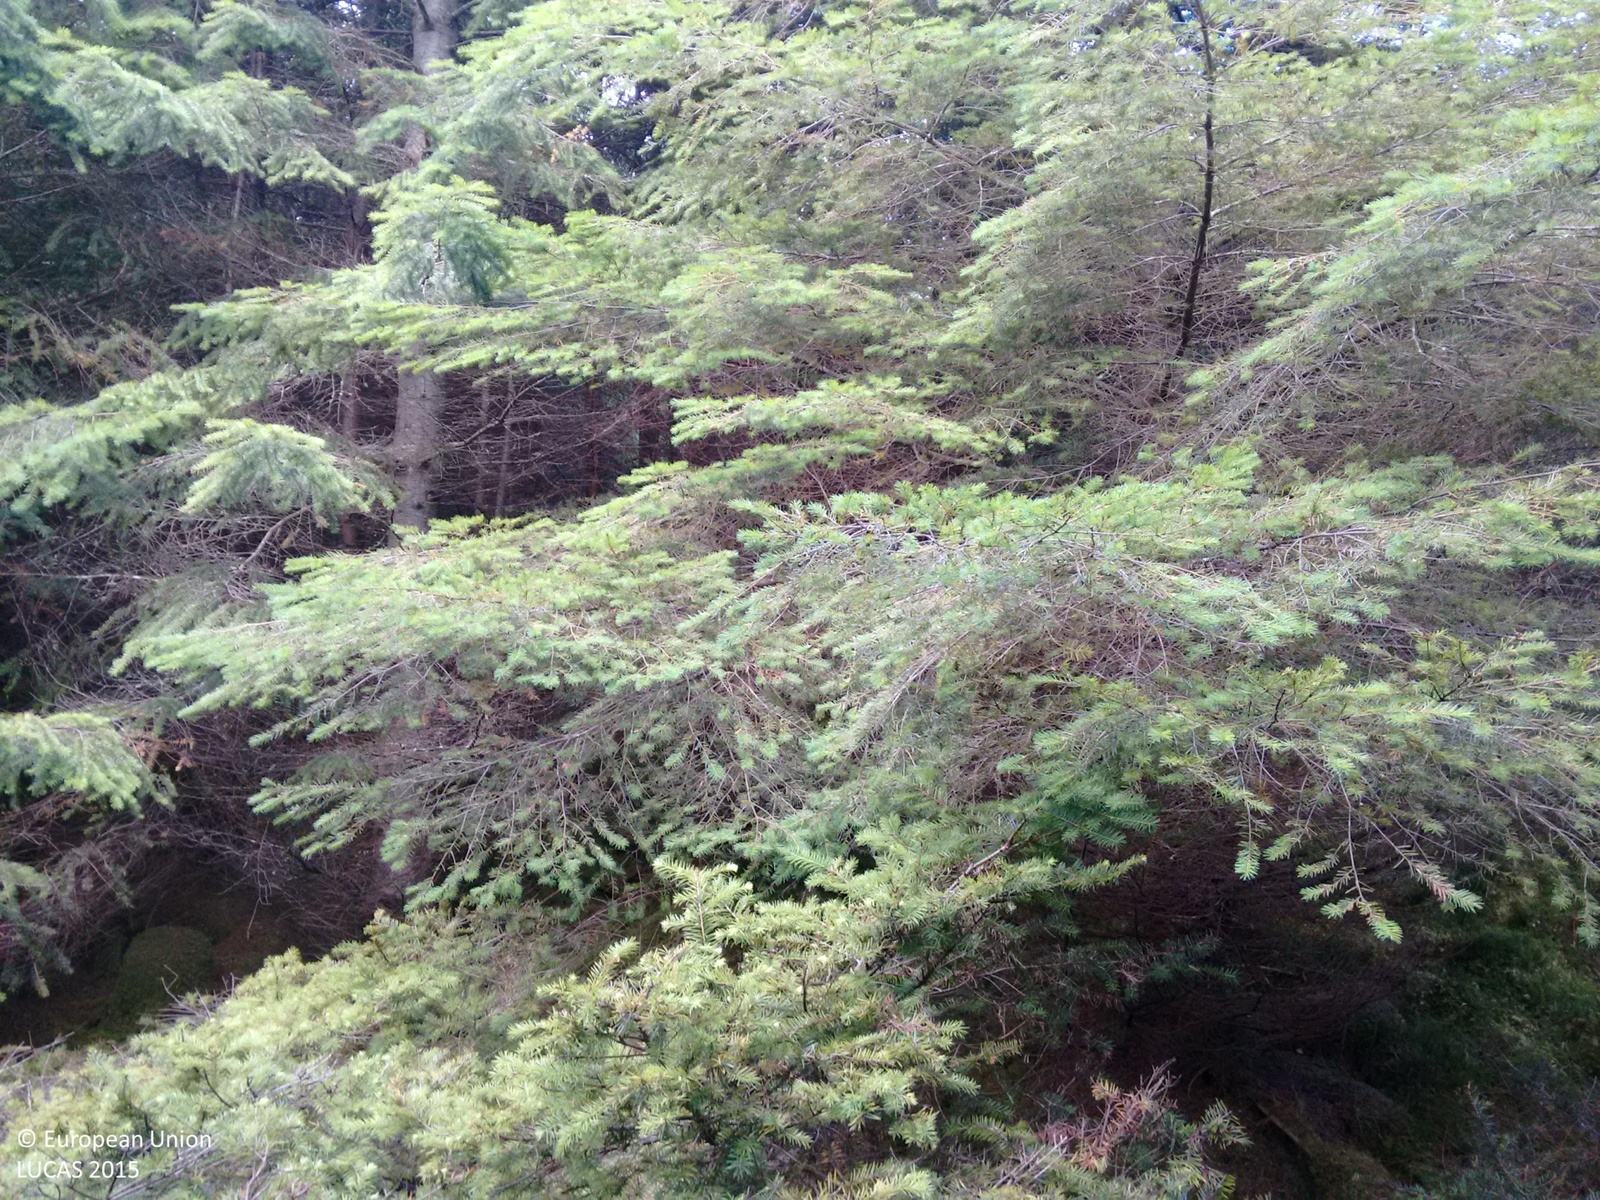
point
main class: Woodland
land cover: Spruce dominated coniferous woodland
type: exotic forest
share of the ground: > 75 %
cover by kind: coniferous forest trees 100 %
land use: Forestry
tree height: > 5 m
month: September
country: GB
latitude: 57.6445
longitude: -4.6868
